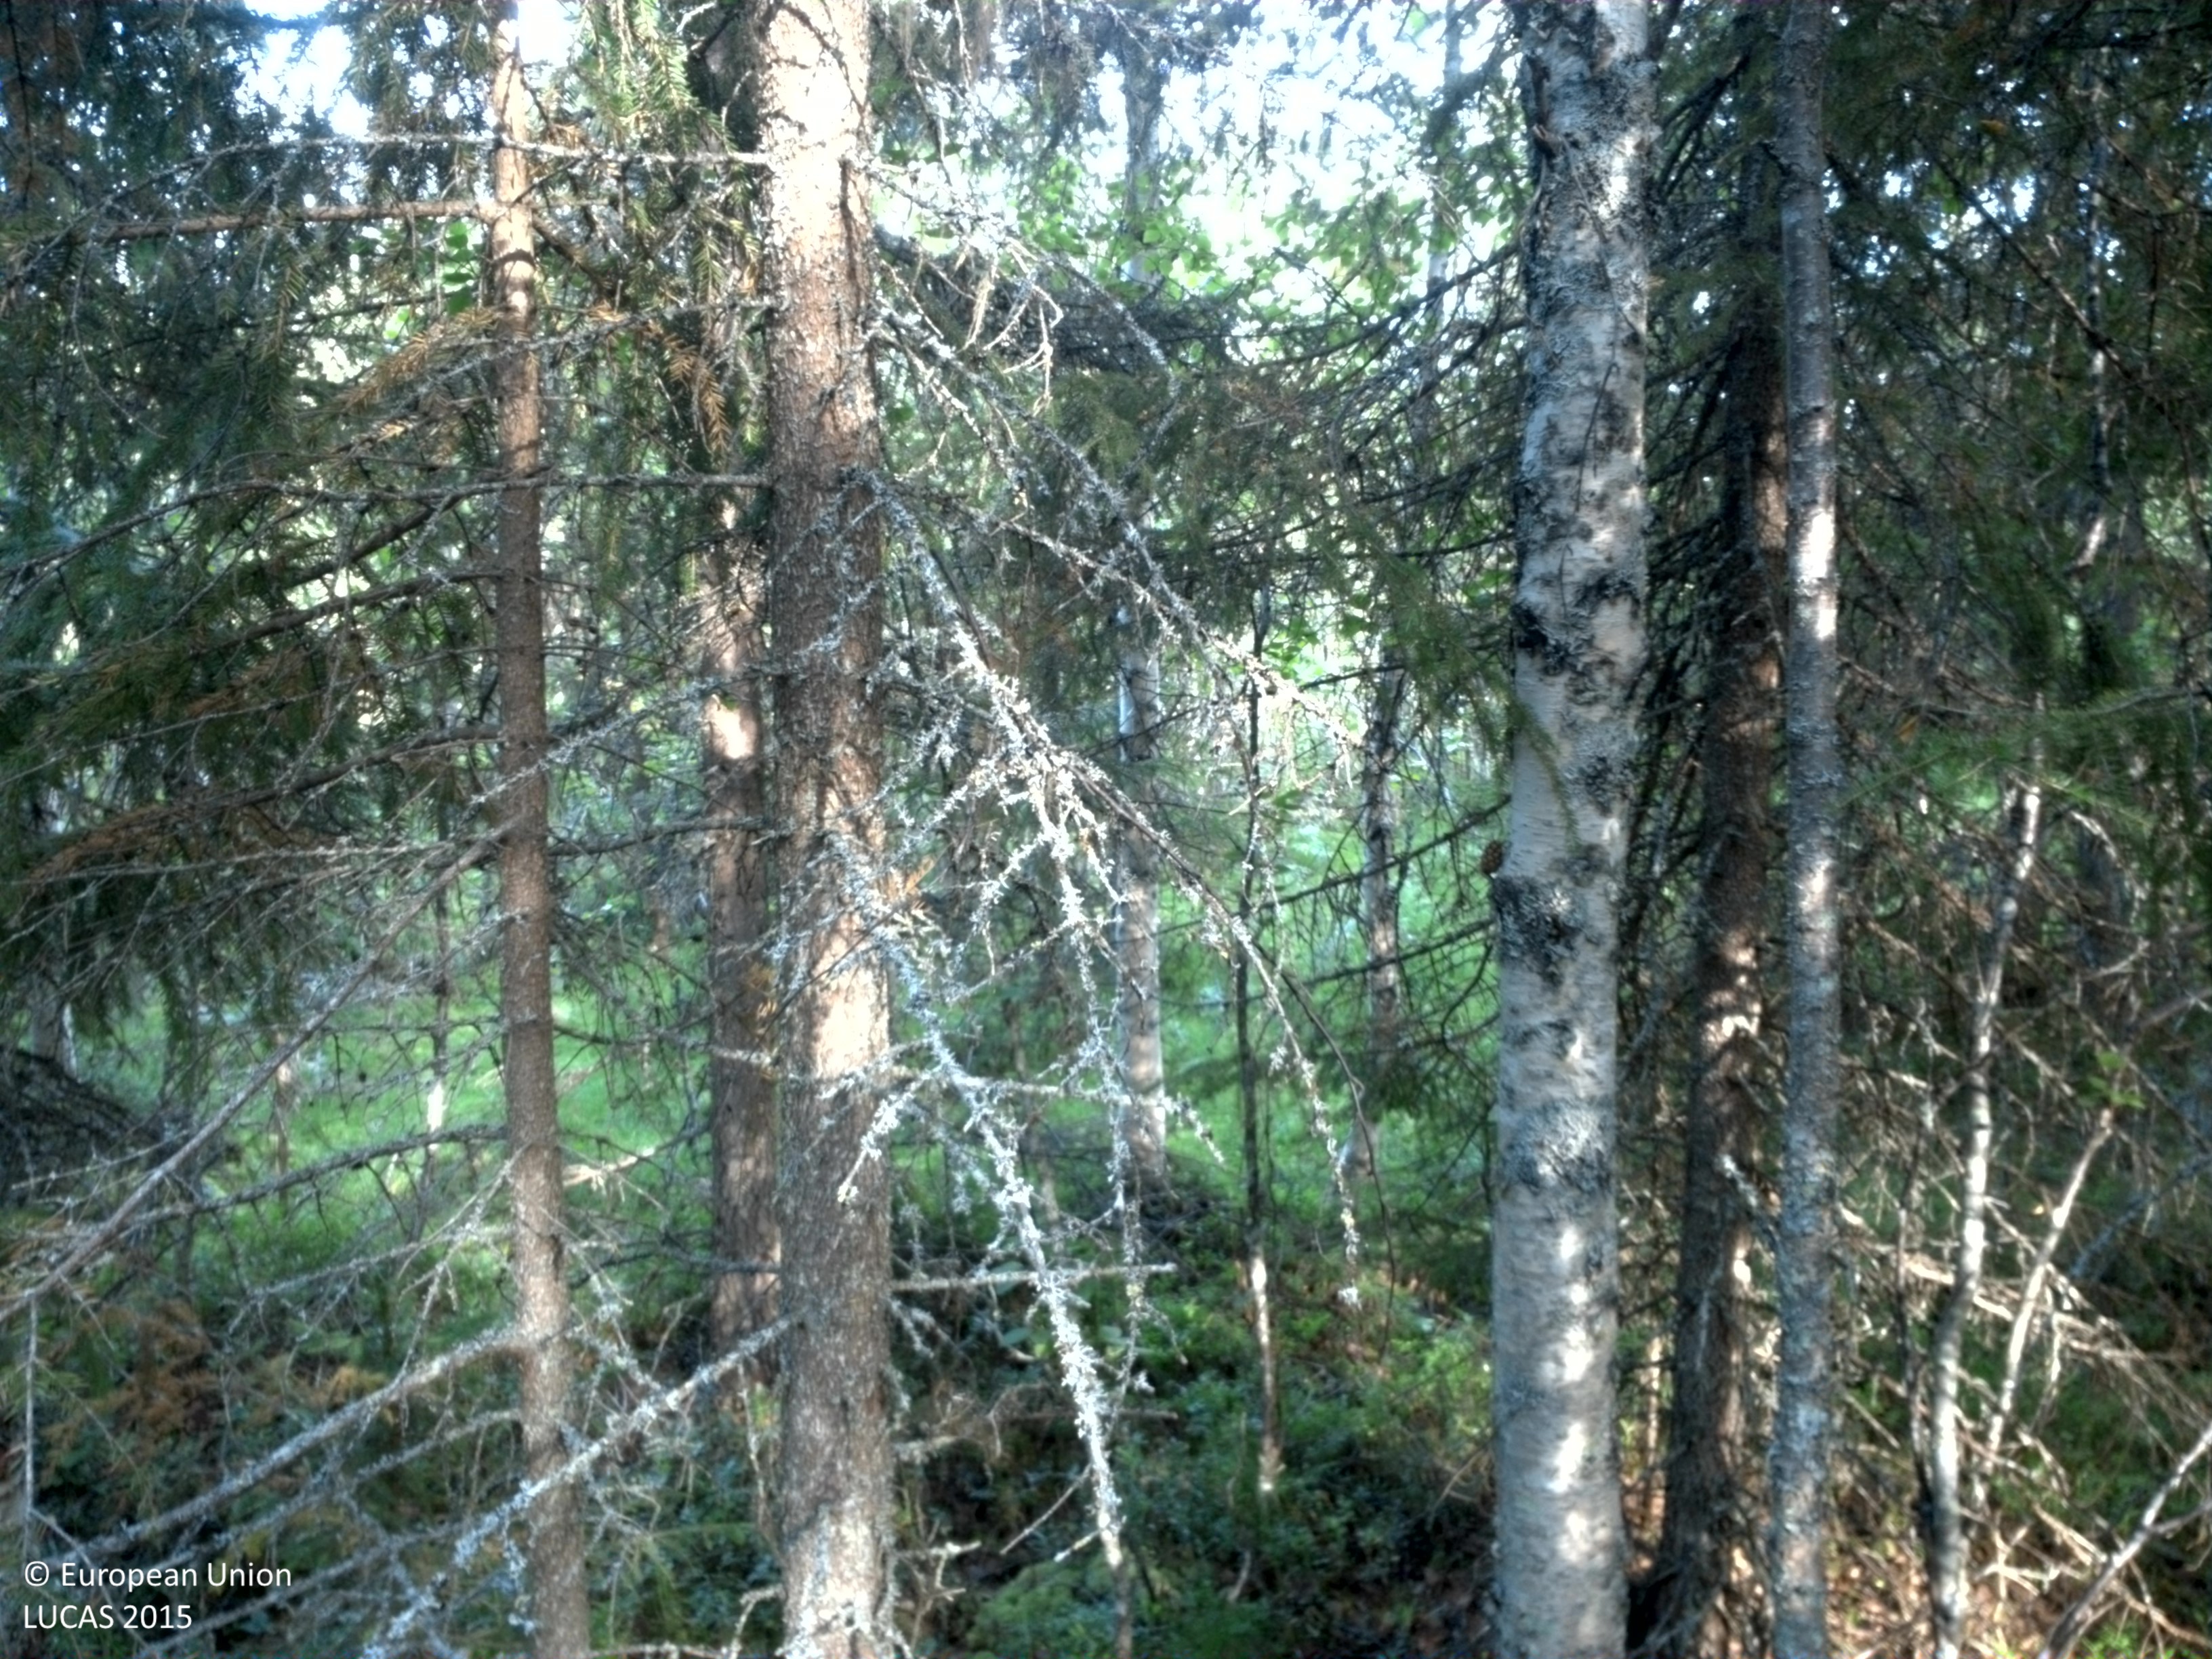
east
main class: Woodland
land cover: Spruce dominated mixed woodland
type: boreal forest
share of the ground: 50 - 75 %
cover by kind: coniferous forest trees 40 %, broadleaved forest trees 25 %, shrubs 25 %, lichens and mosses 10 %
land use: Forestry
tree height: > 5 m
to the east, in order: Spruce dominated mixed woodland; Broadleaved woodland; Tracks; Spruce dominated mixed woodland; Other mixed woodland; Broadleaved woodland; Other mixed woodland; Tracks; Other coniferous woodland
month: August
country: SE
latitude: 64.7381
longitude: 16.4559
